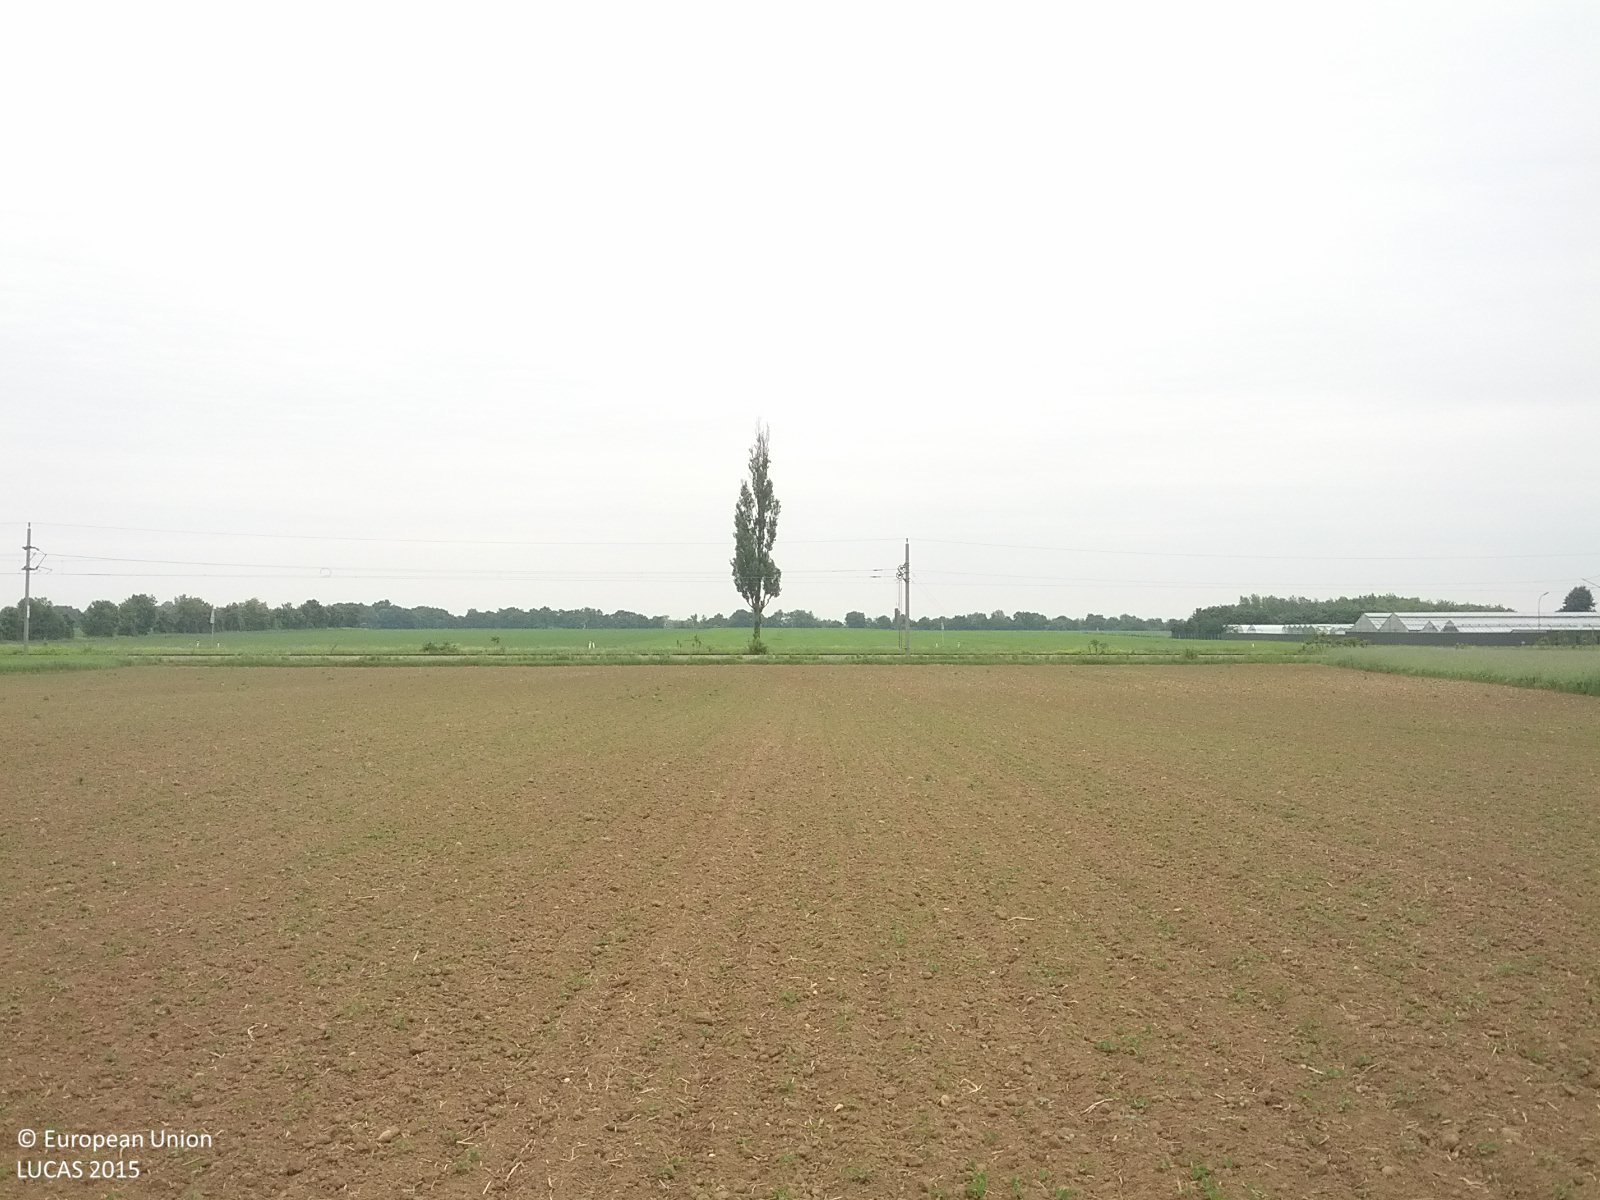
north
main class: Cropland
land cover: Soya
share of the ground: < 10 %
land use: Agriculture (excluding fallow land and kitchen gardens)
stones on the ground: < 10 %
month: May
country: AT
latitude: 48.1062
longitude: 16.7616
